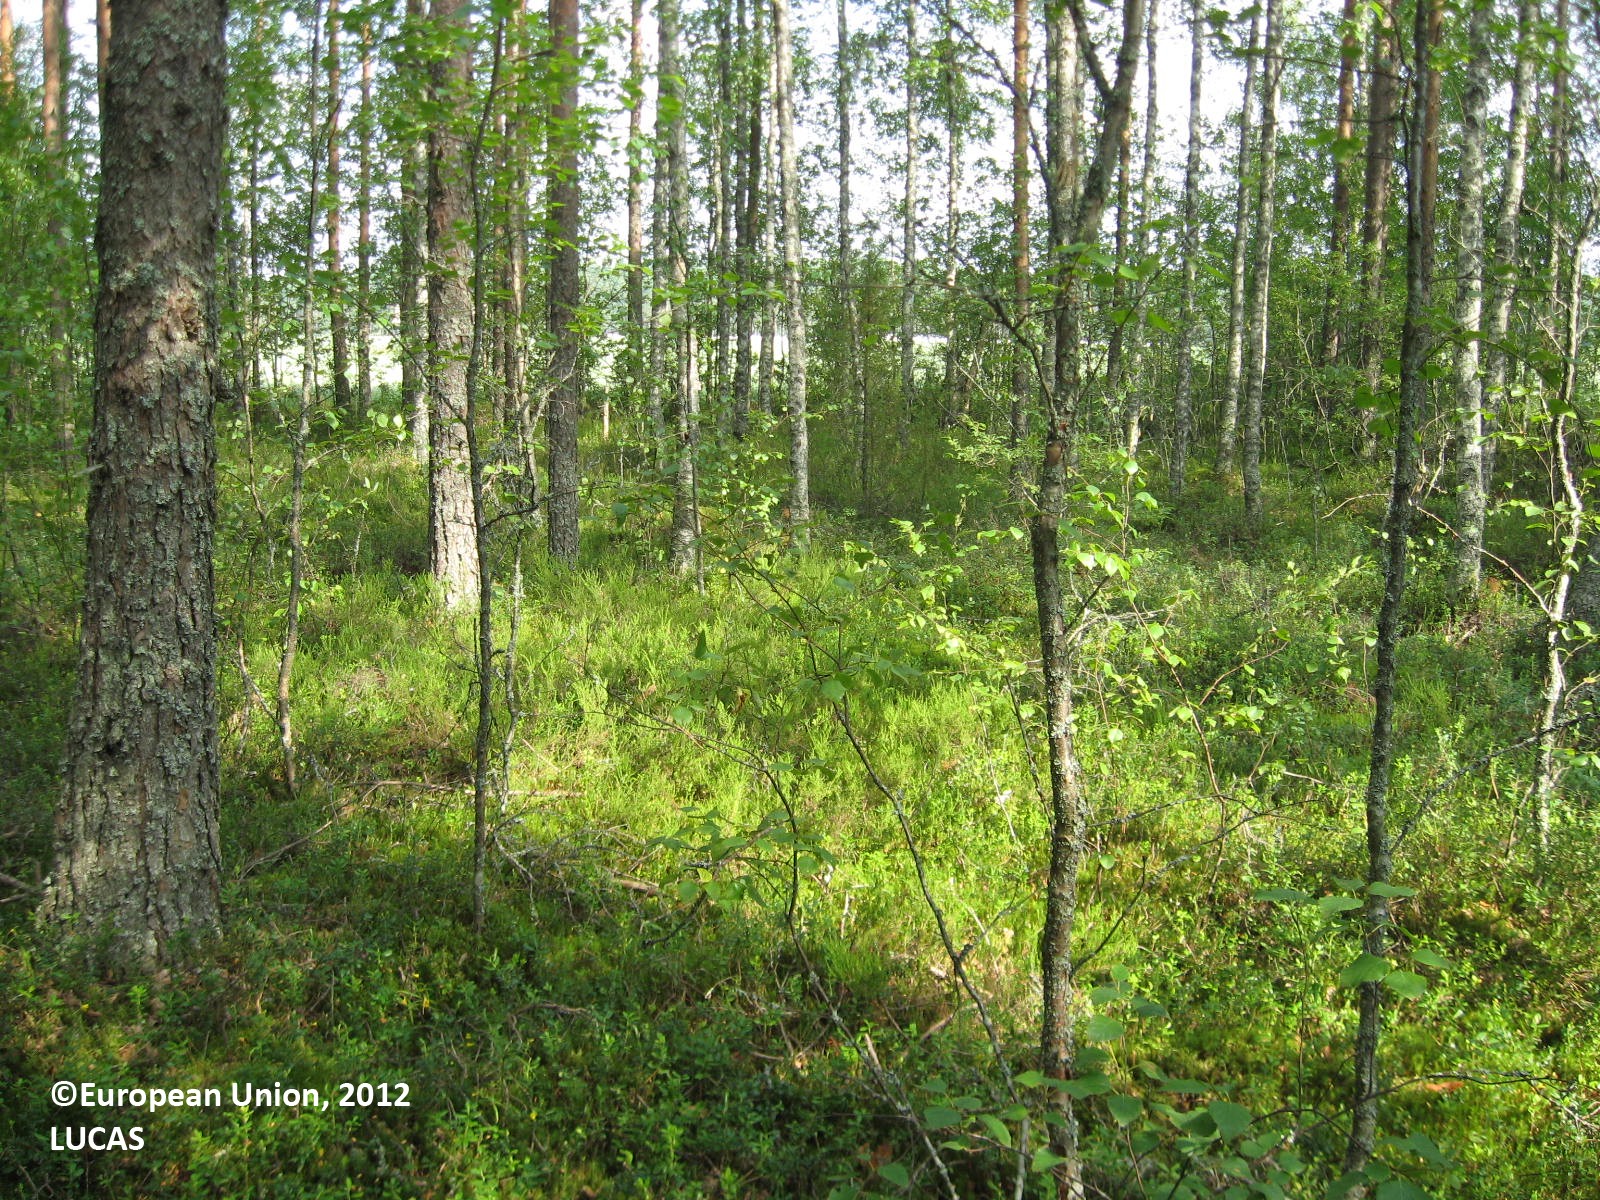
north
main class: Woodland
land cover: Pine dominated mixed woodland
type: boreal forest
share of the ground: > 75 %
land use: Forestry
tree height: > 5 m
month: July
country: FI
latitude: 61.8987
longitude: 22.3715
